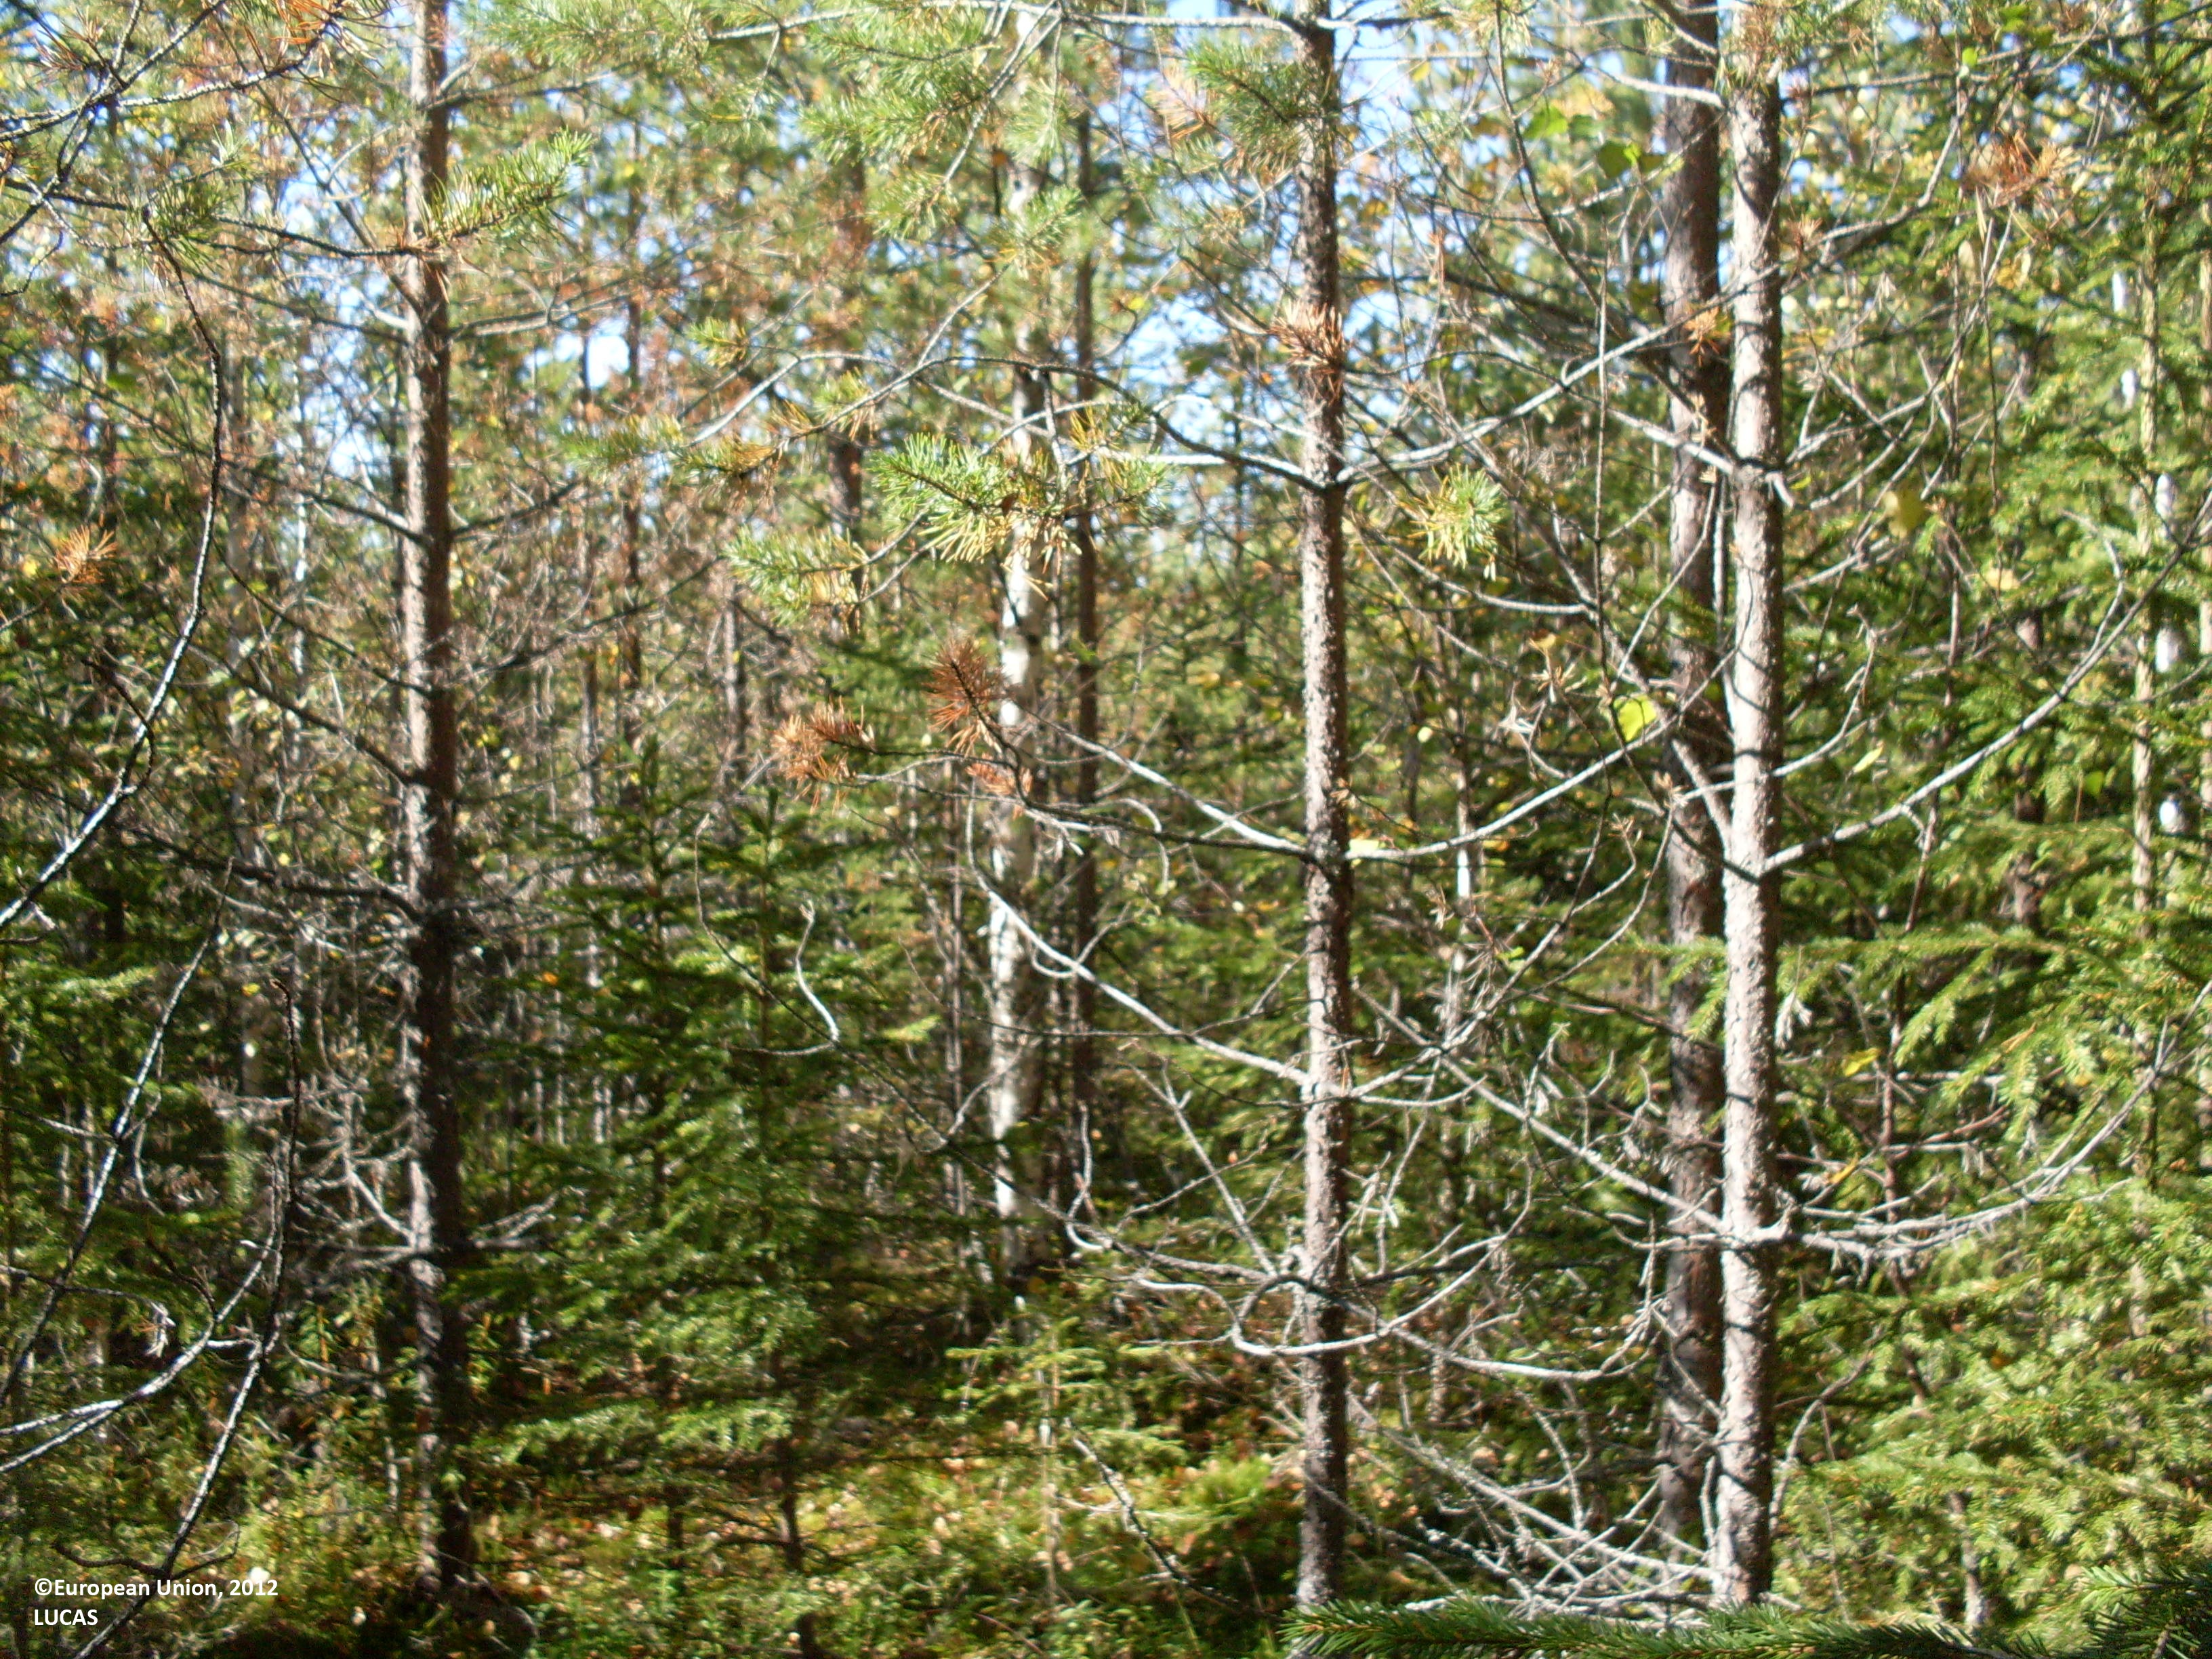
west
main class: Woodland
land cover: Spruce dominated mixed woodland
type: boreal forest
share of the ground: > 75 %
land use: Forestry
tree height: > 5 m
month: September
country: FI
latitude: 64.0446
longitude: 29.2339
